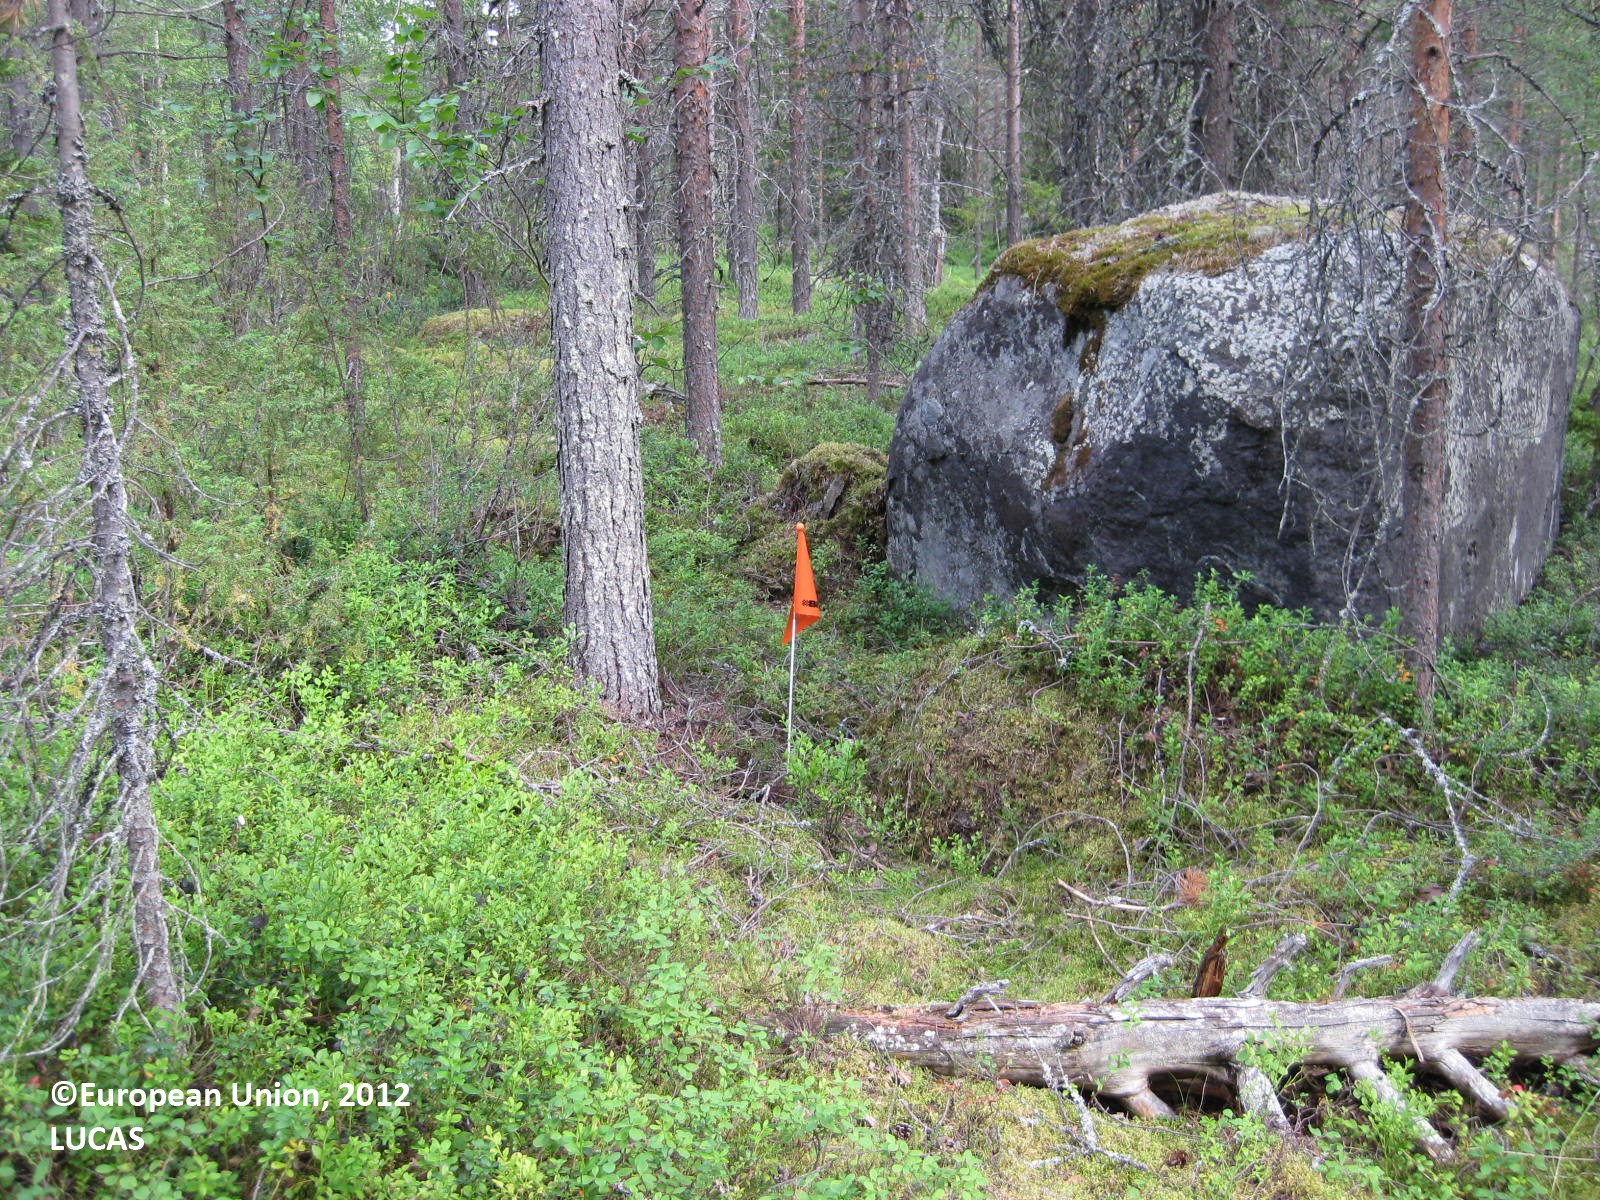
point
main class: Woodland
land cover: Pine dominated coniferous woodland
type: boreal forest
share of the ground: 50 - 75 %
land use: Forestry
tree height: > 5 m
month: July
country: FI
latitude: 65.7428
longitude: 28.5035
